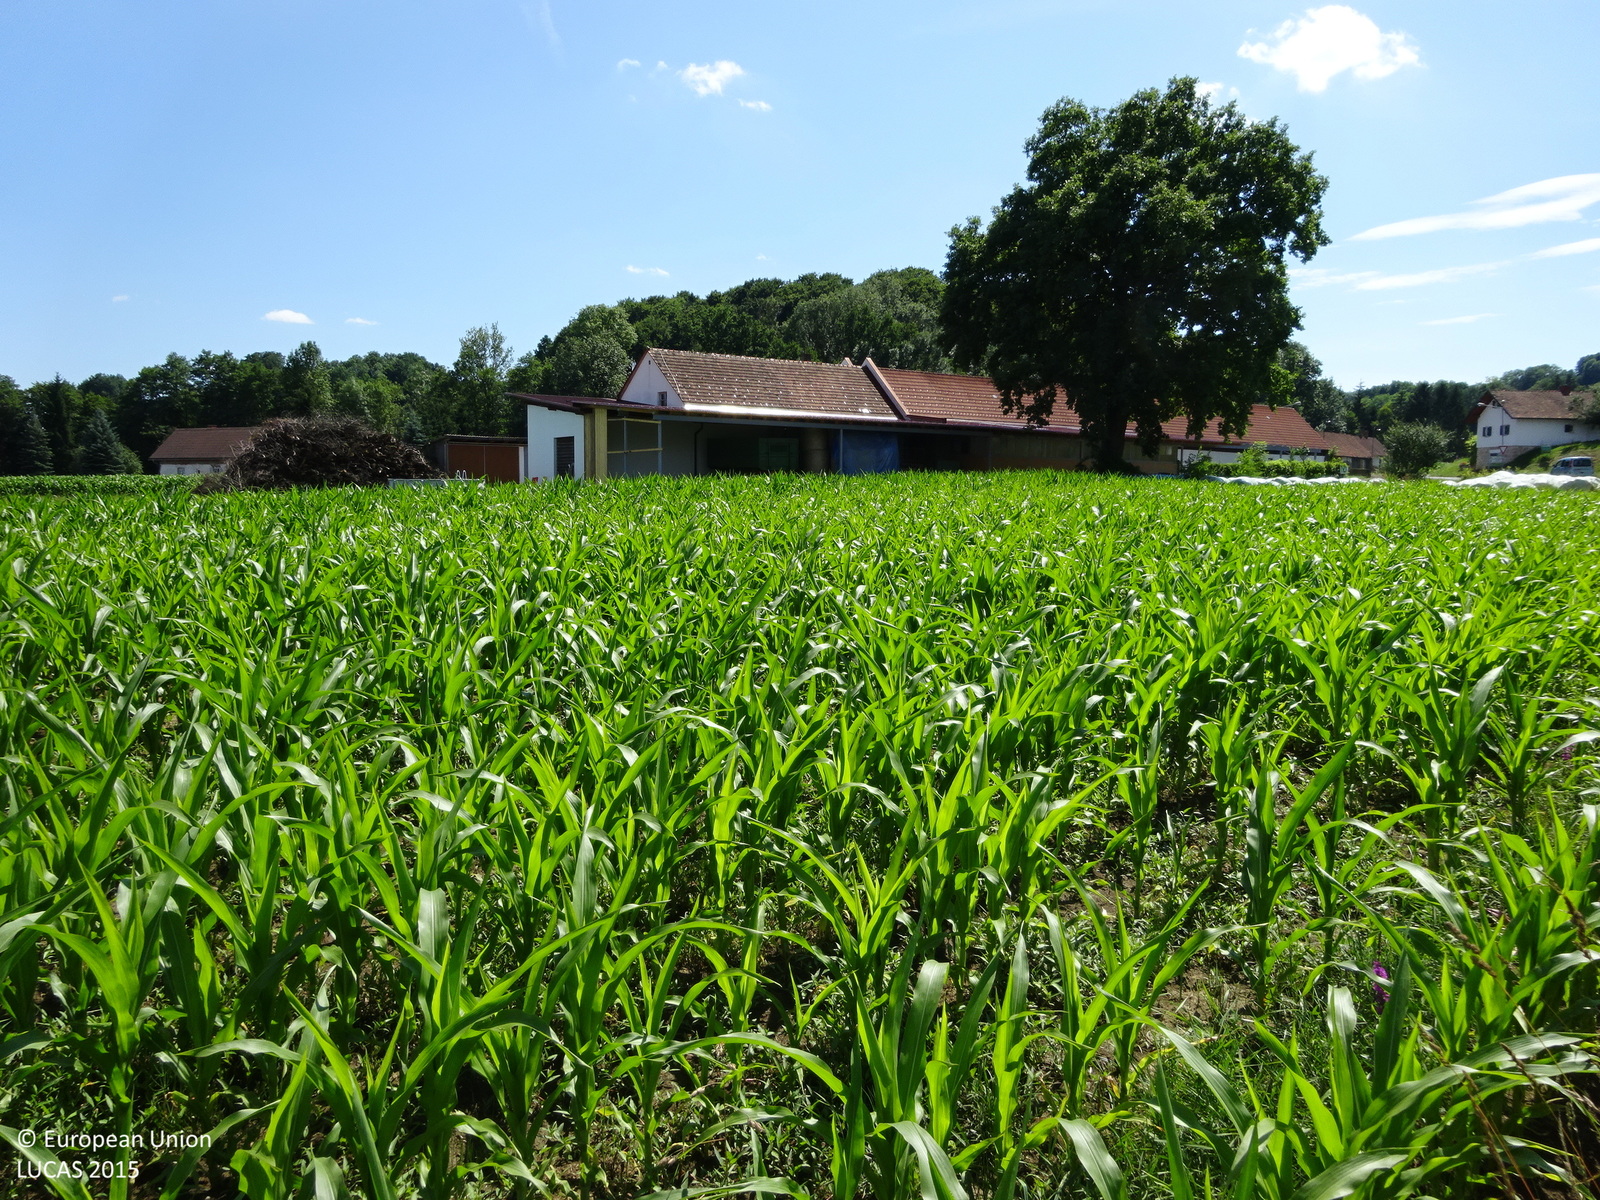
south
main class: Cropland
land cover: Maize
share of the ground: > 75 %
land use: Agriculture (excluding fallow land and kitchen gardens)
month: June
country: AT
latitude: 46.8031
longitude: 15.8836
